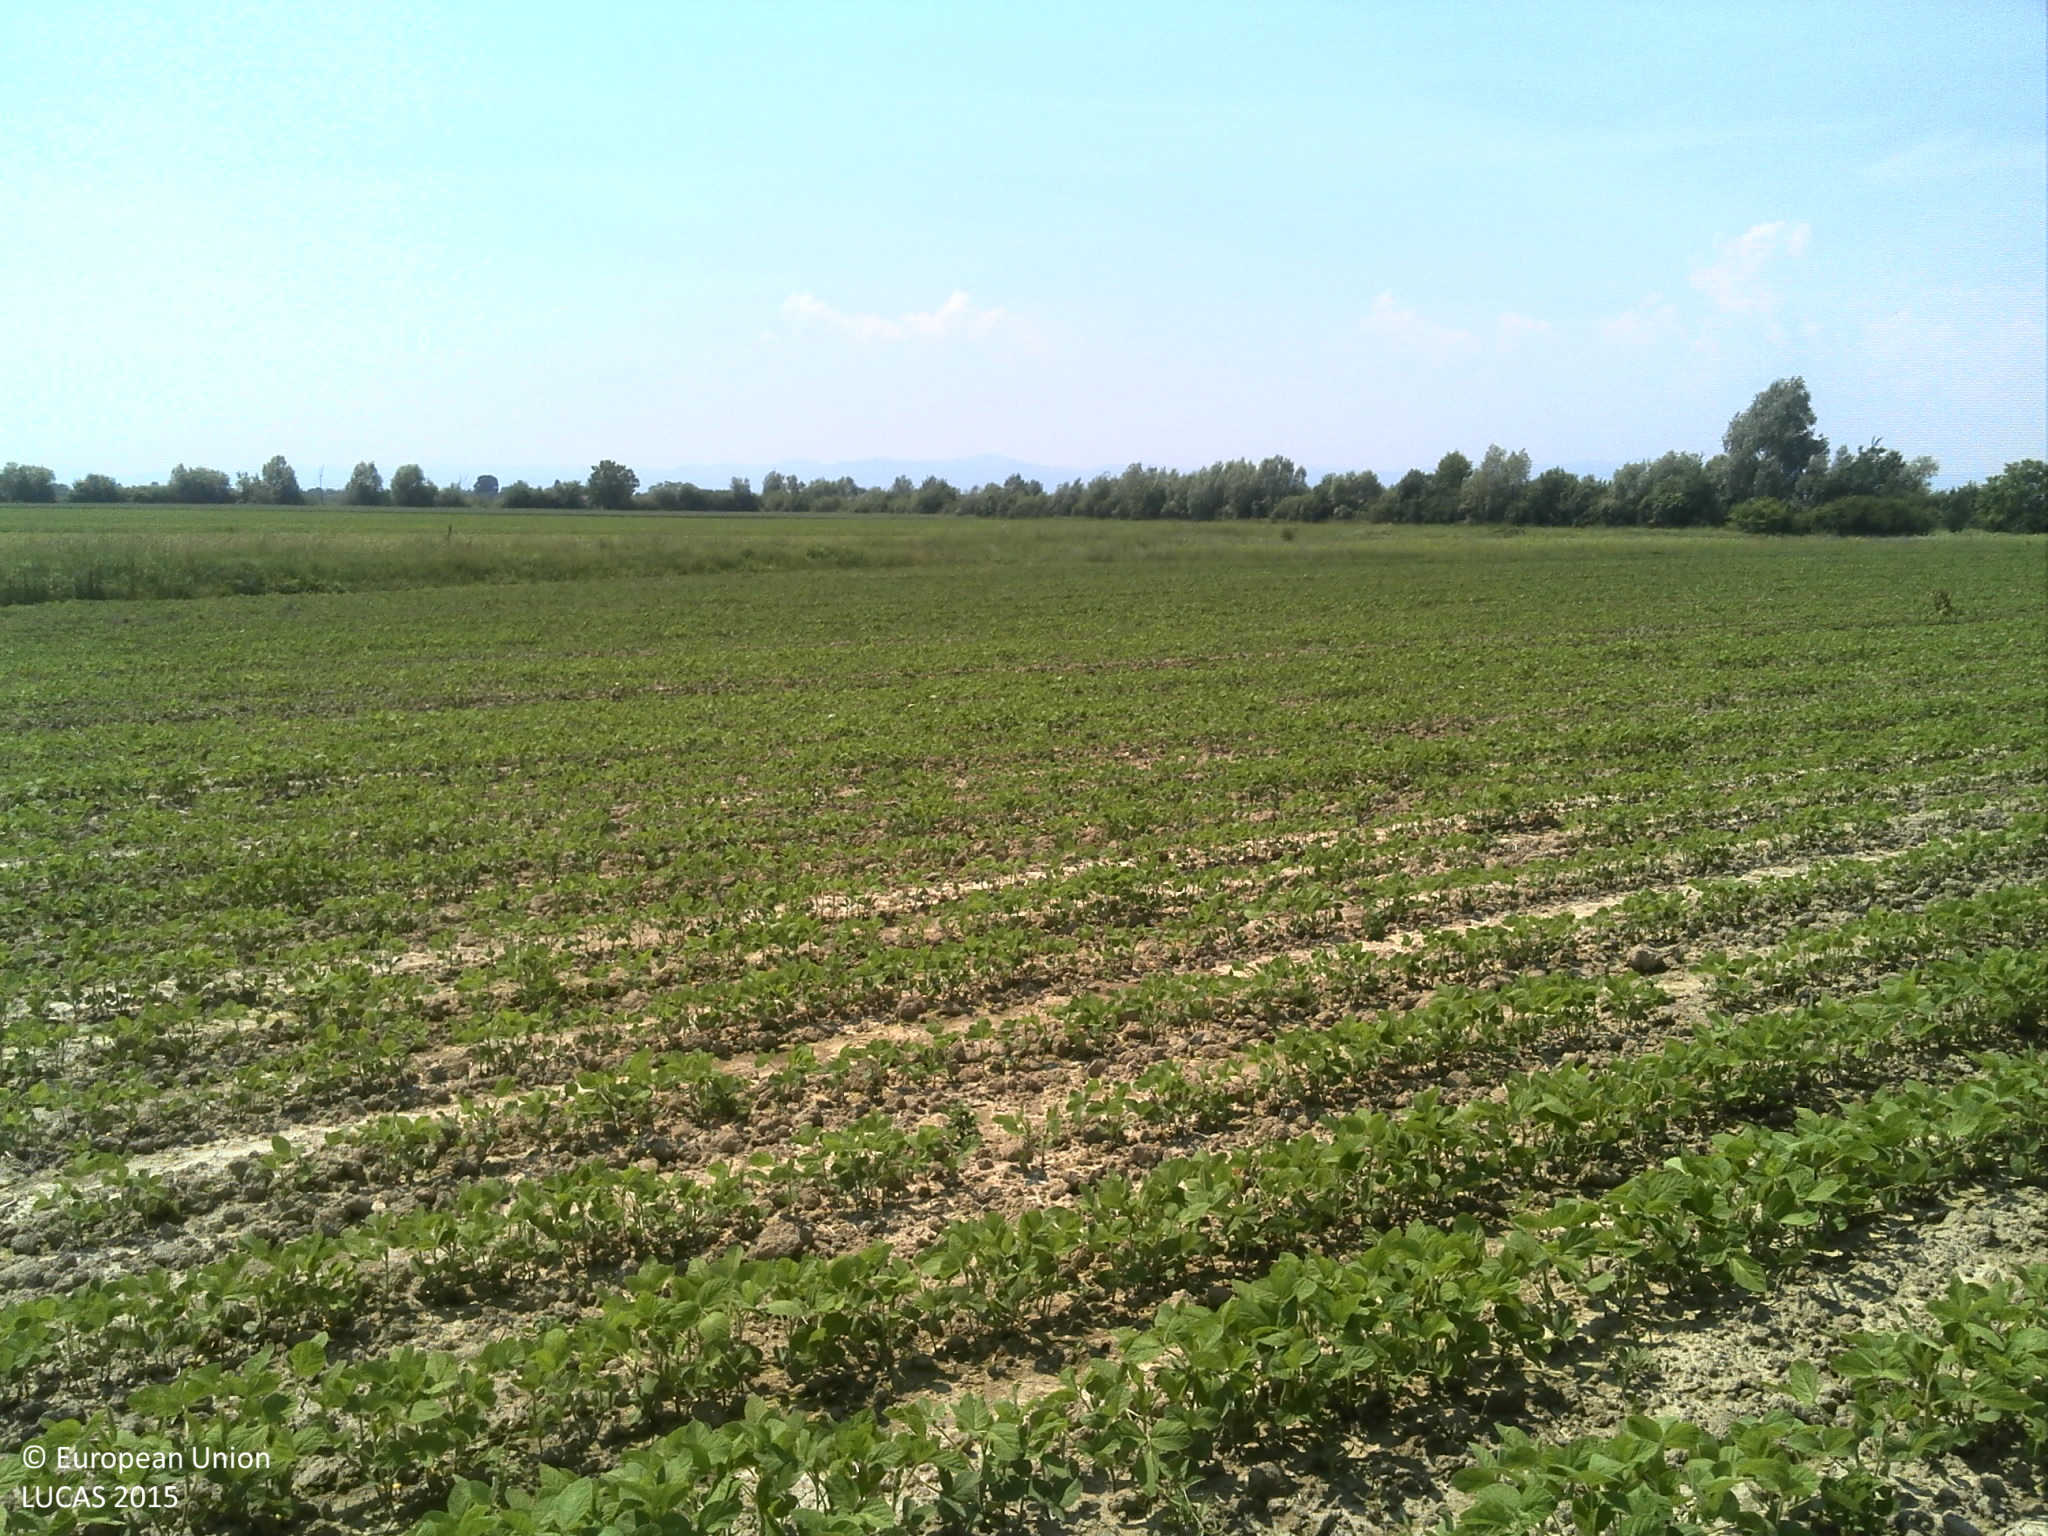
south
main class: Cropland
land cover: Soya
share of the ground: 10 - 25 %
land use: Agriculture (excluding fallow land and kitchen gardens)
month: June
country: HR
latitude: 45.6730
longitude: 17.9761
